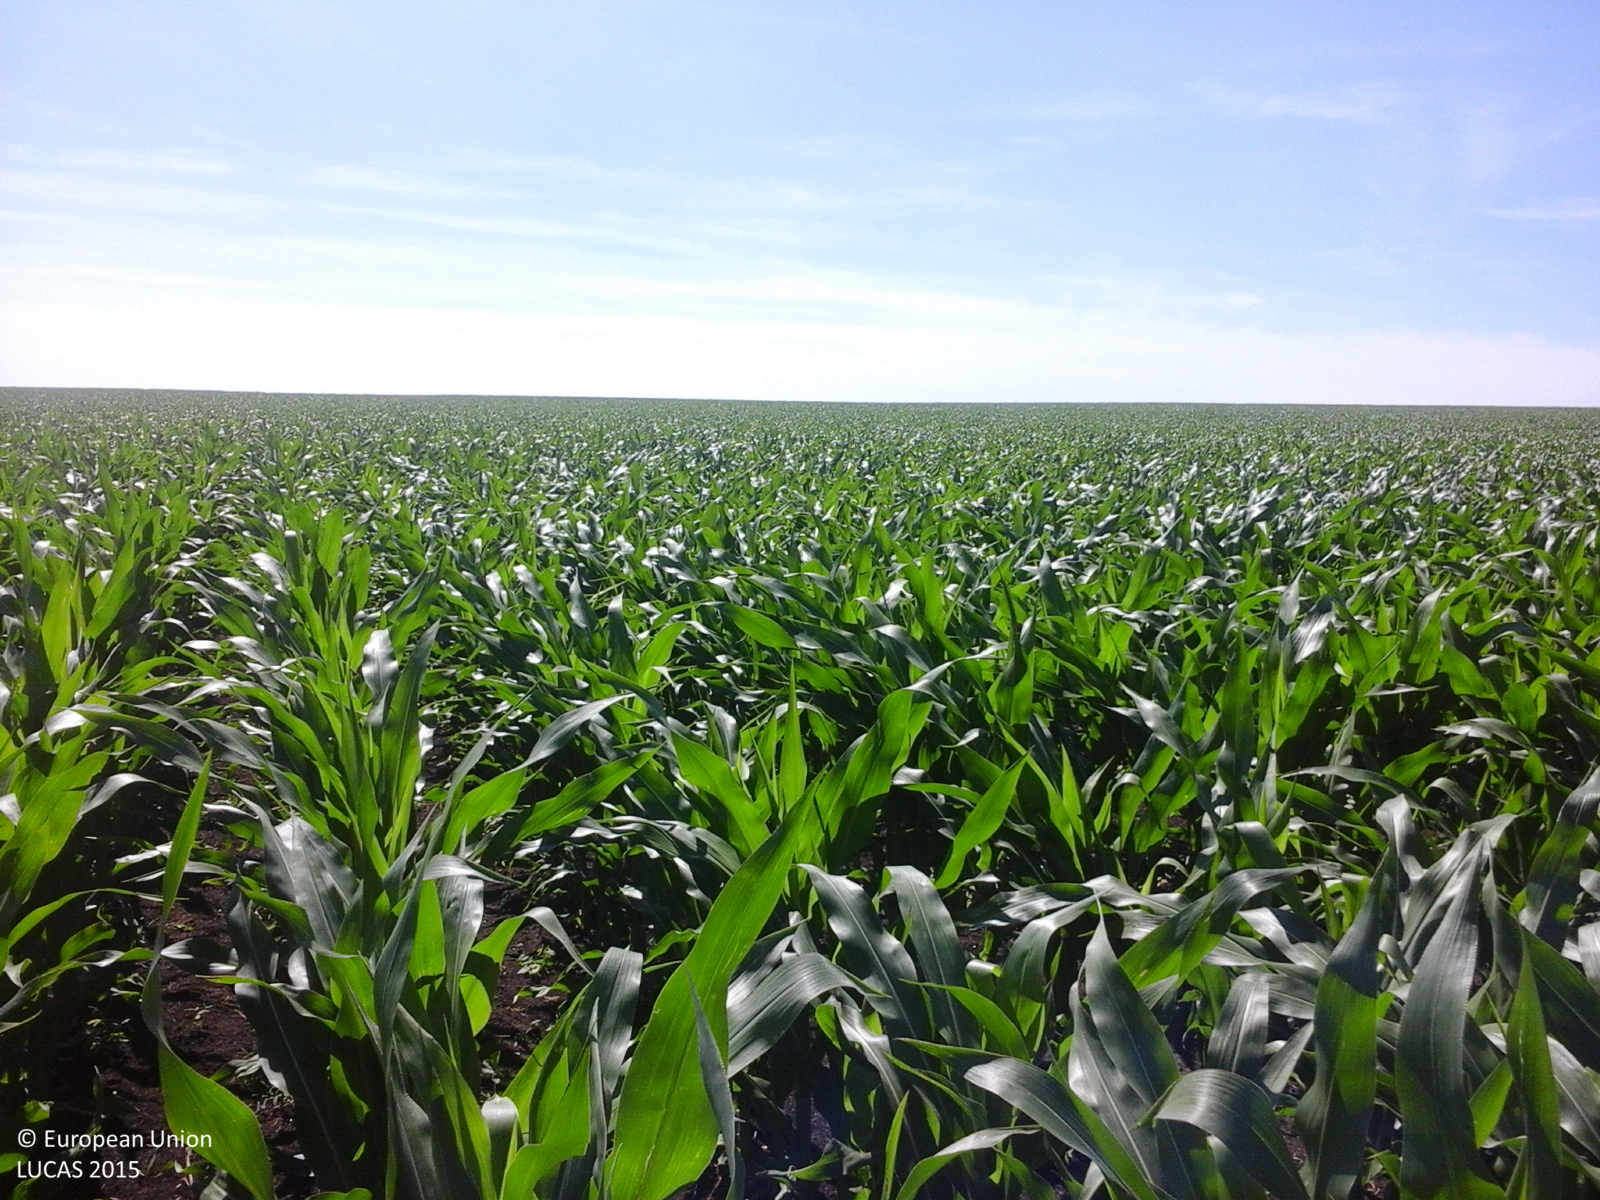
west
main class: Cropland
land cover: Maize
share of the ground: > 75 %
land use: Agriculture (excluding fallow land and kitchen gardens)
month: June
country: RO
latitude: 47.5284
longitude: 27.1490
